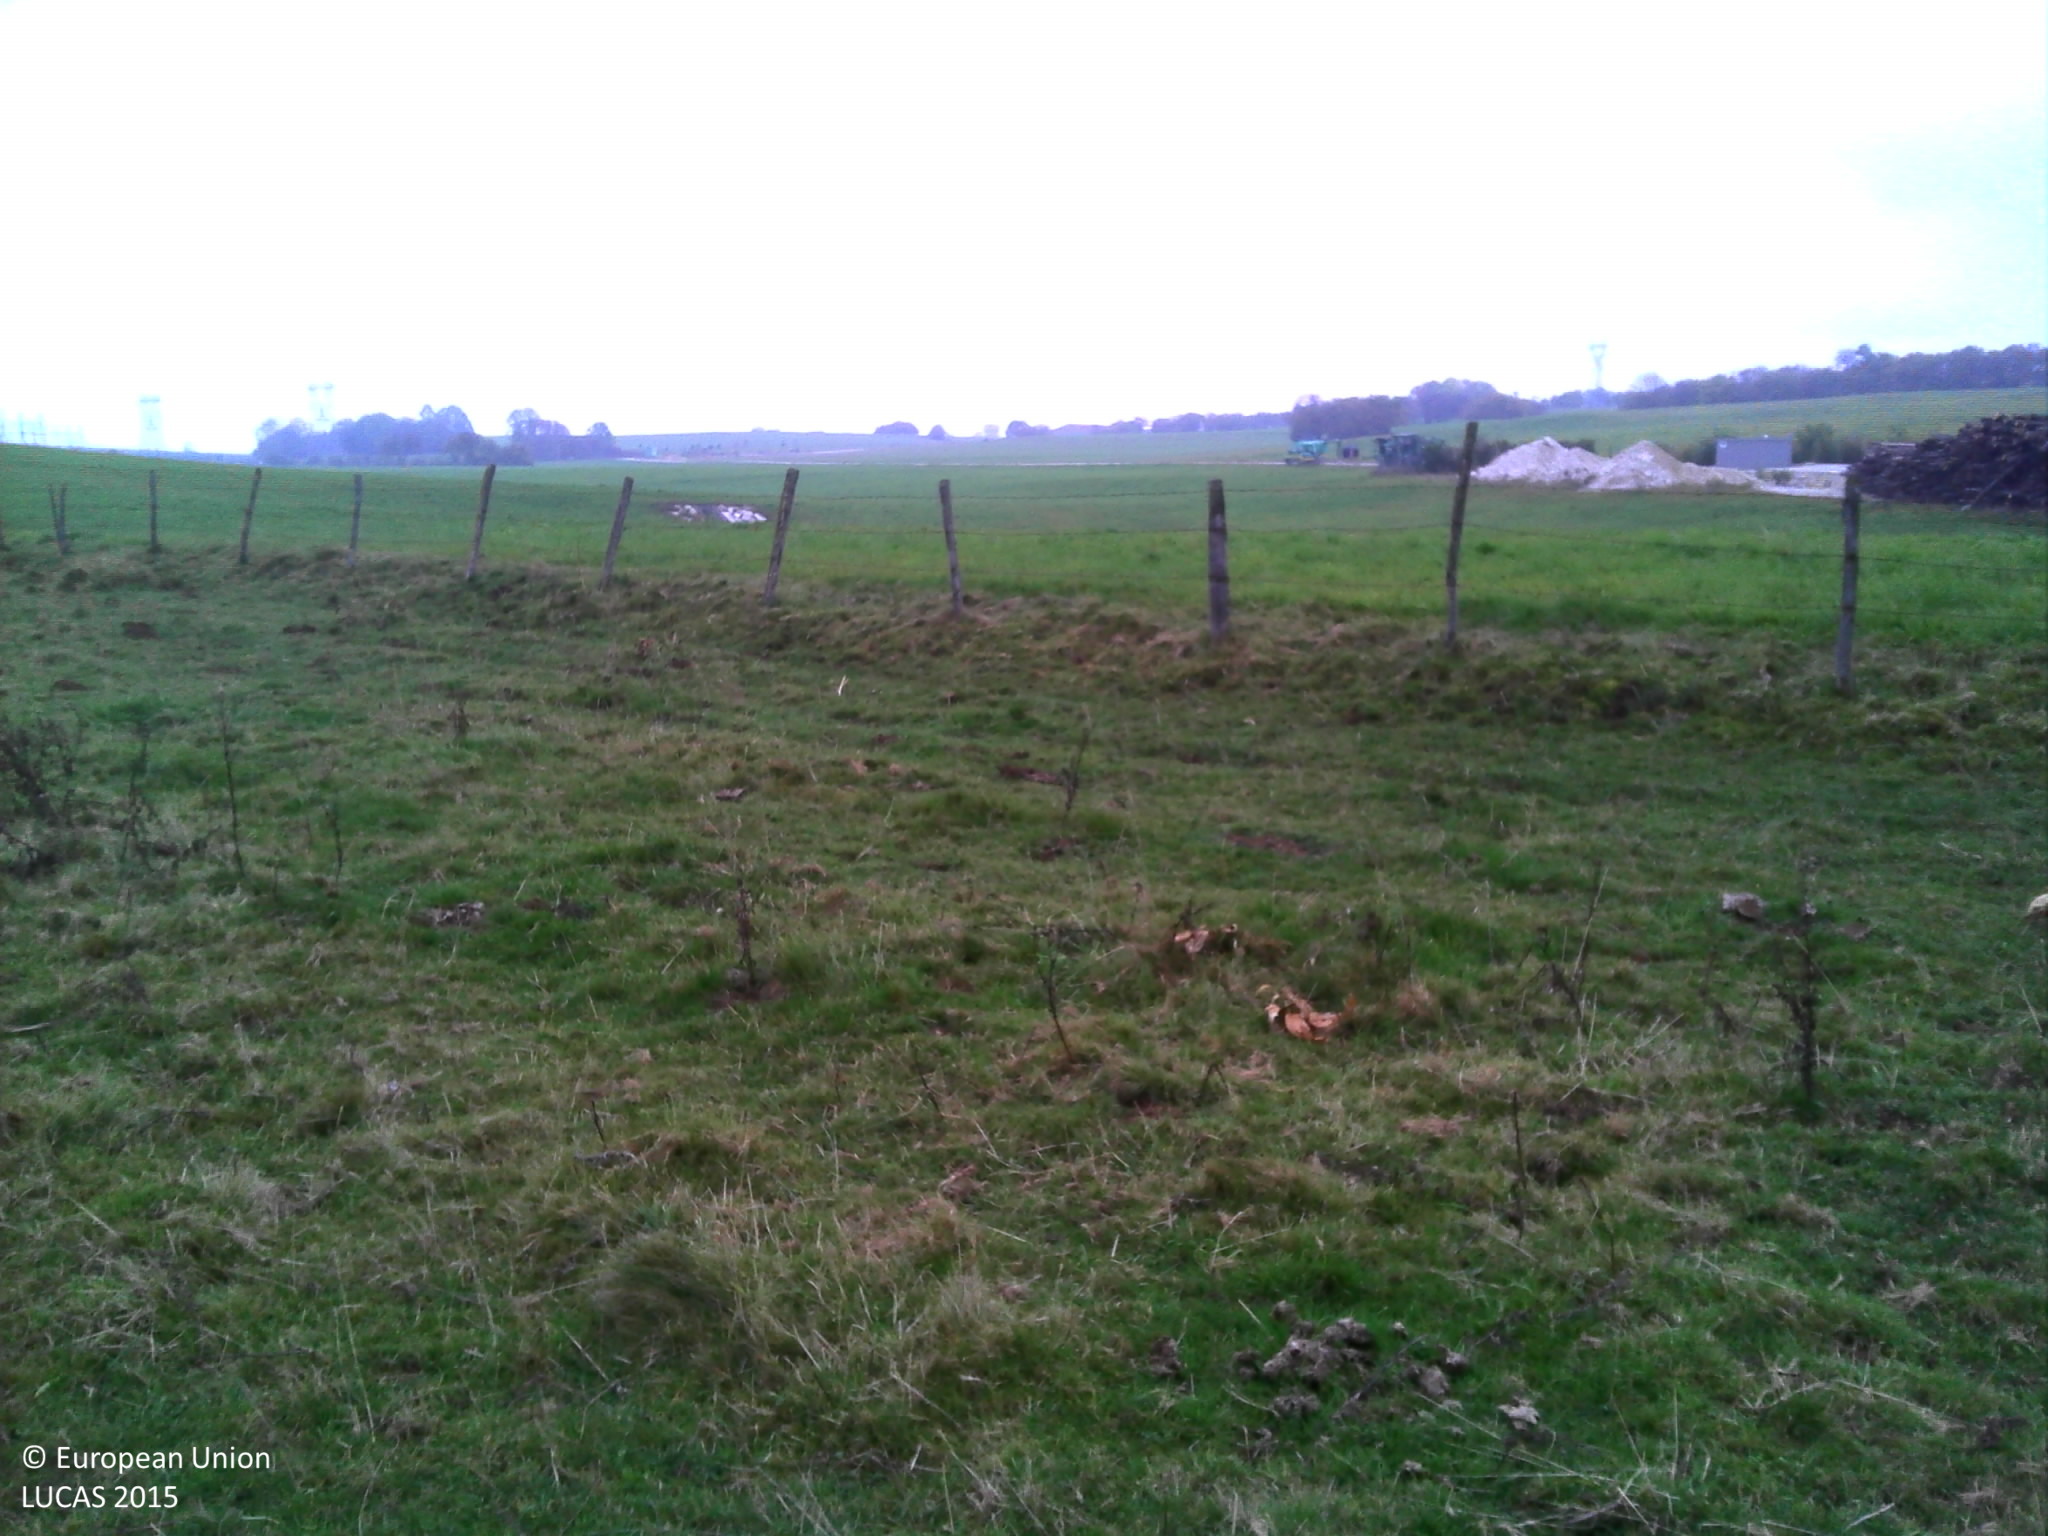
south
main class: Grassland
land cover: Grassland without tree/shrub cover
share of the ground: > 75 %
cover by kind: herbaceous plants 100 %
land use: Agriculture (excluding fallow land and kitchen gardens)
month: October
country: FR
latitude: 46.8772
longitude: 6.1579
